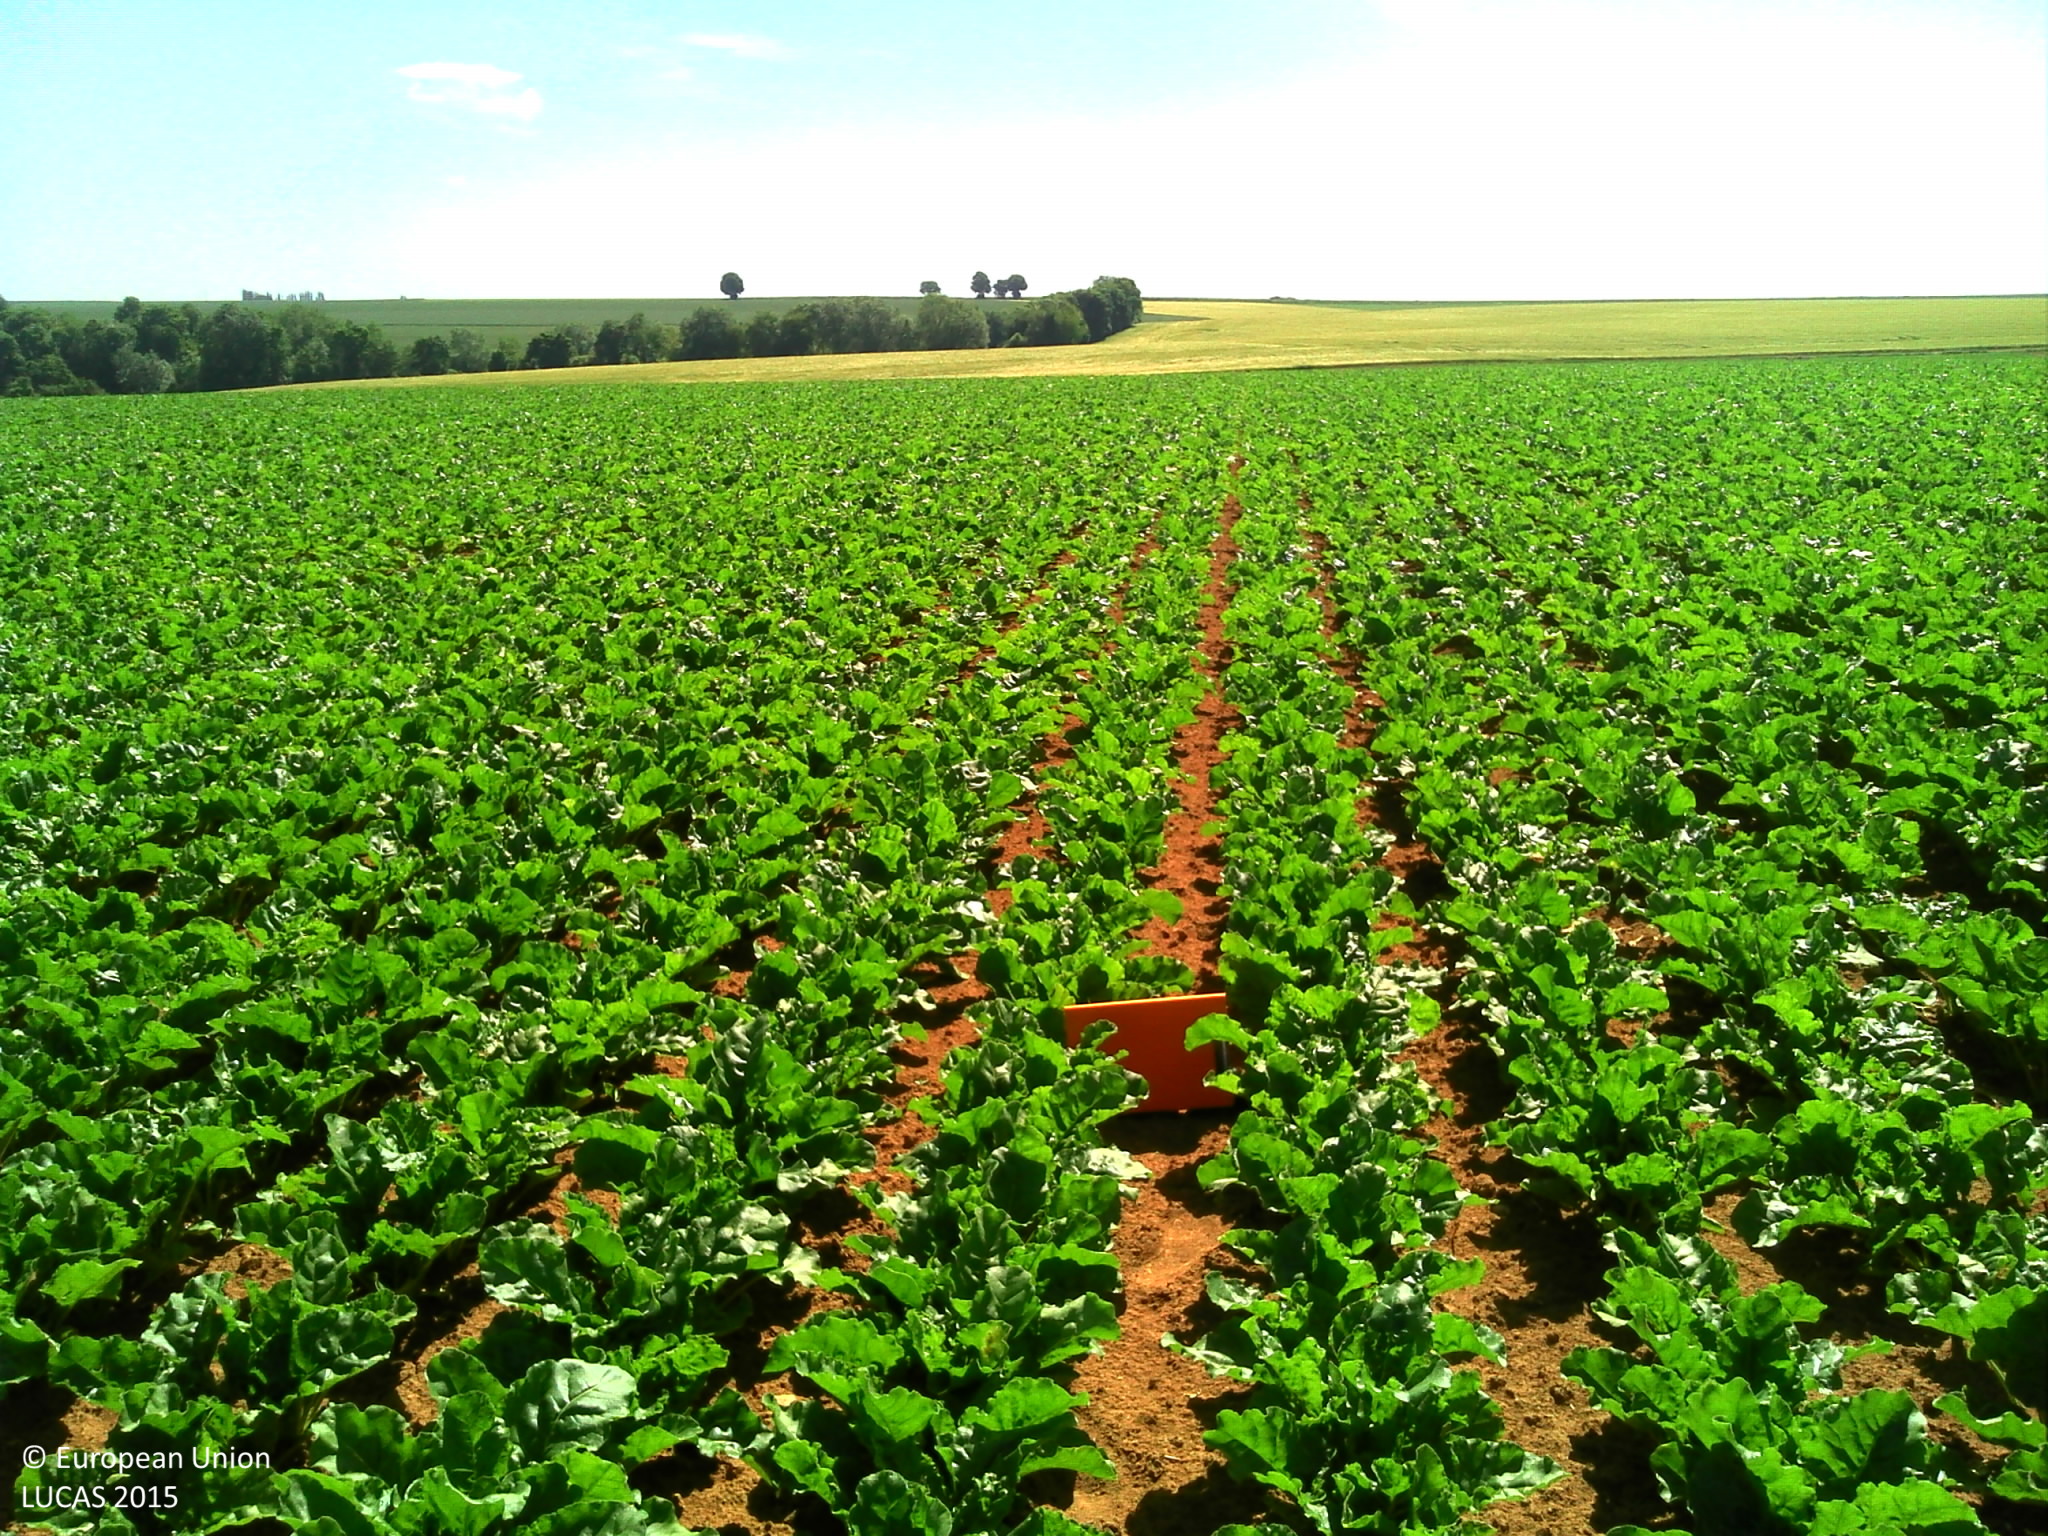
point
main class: Cropland
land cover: Sugar beet
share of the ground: > 75 %
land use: Agriculture (excluding fallow land and kitchen gardens)
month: June
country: FR
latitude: 49.4442
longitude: 3.2751
